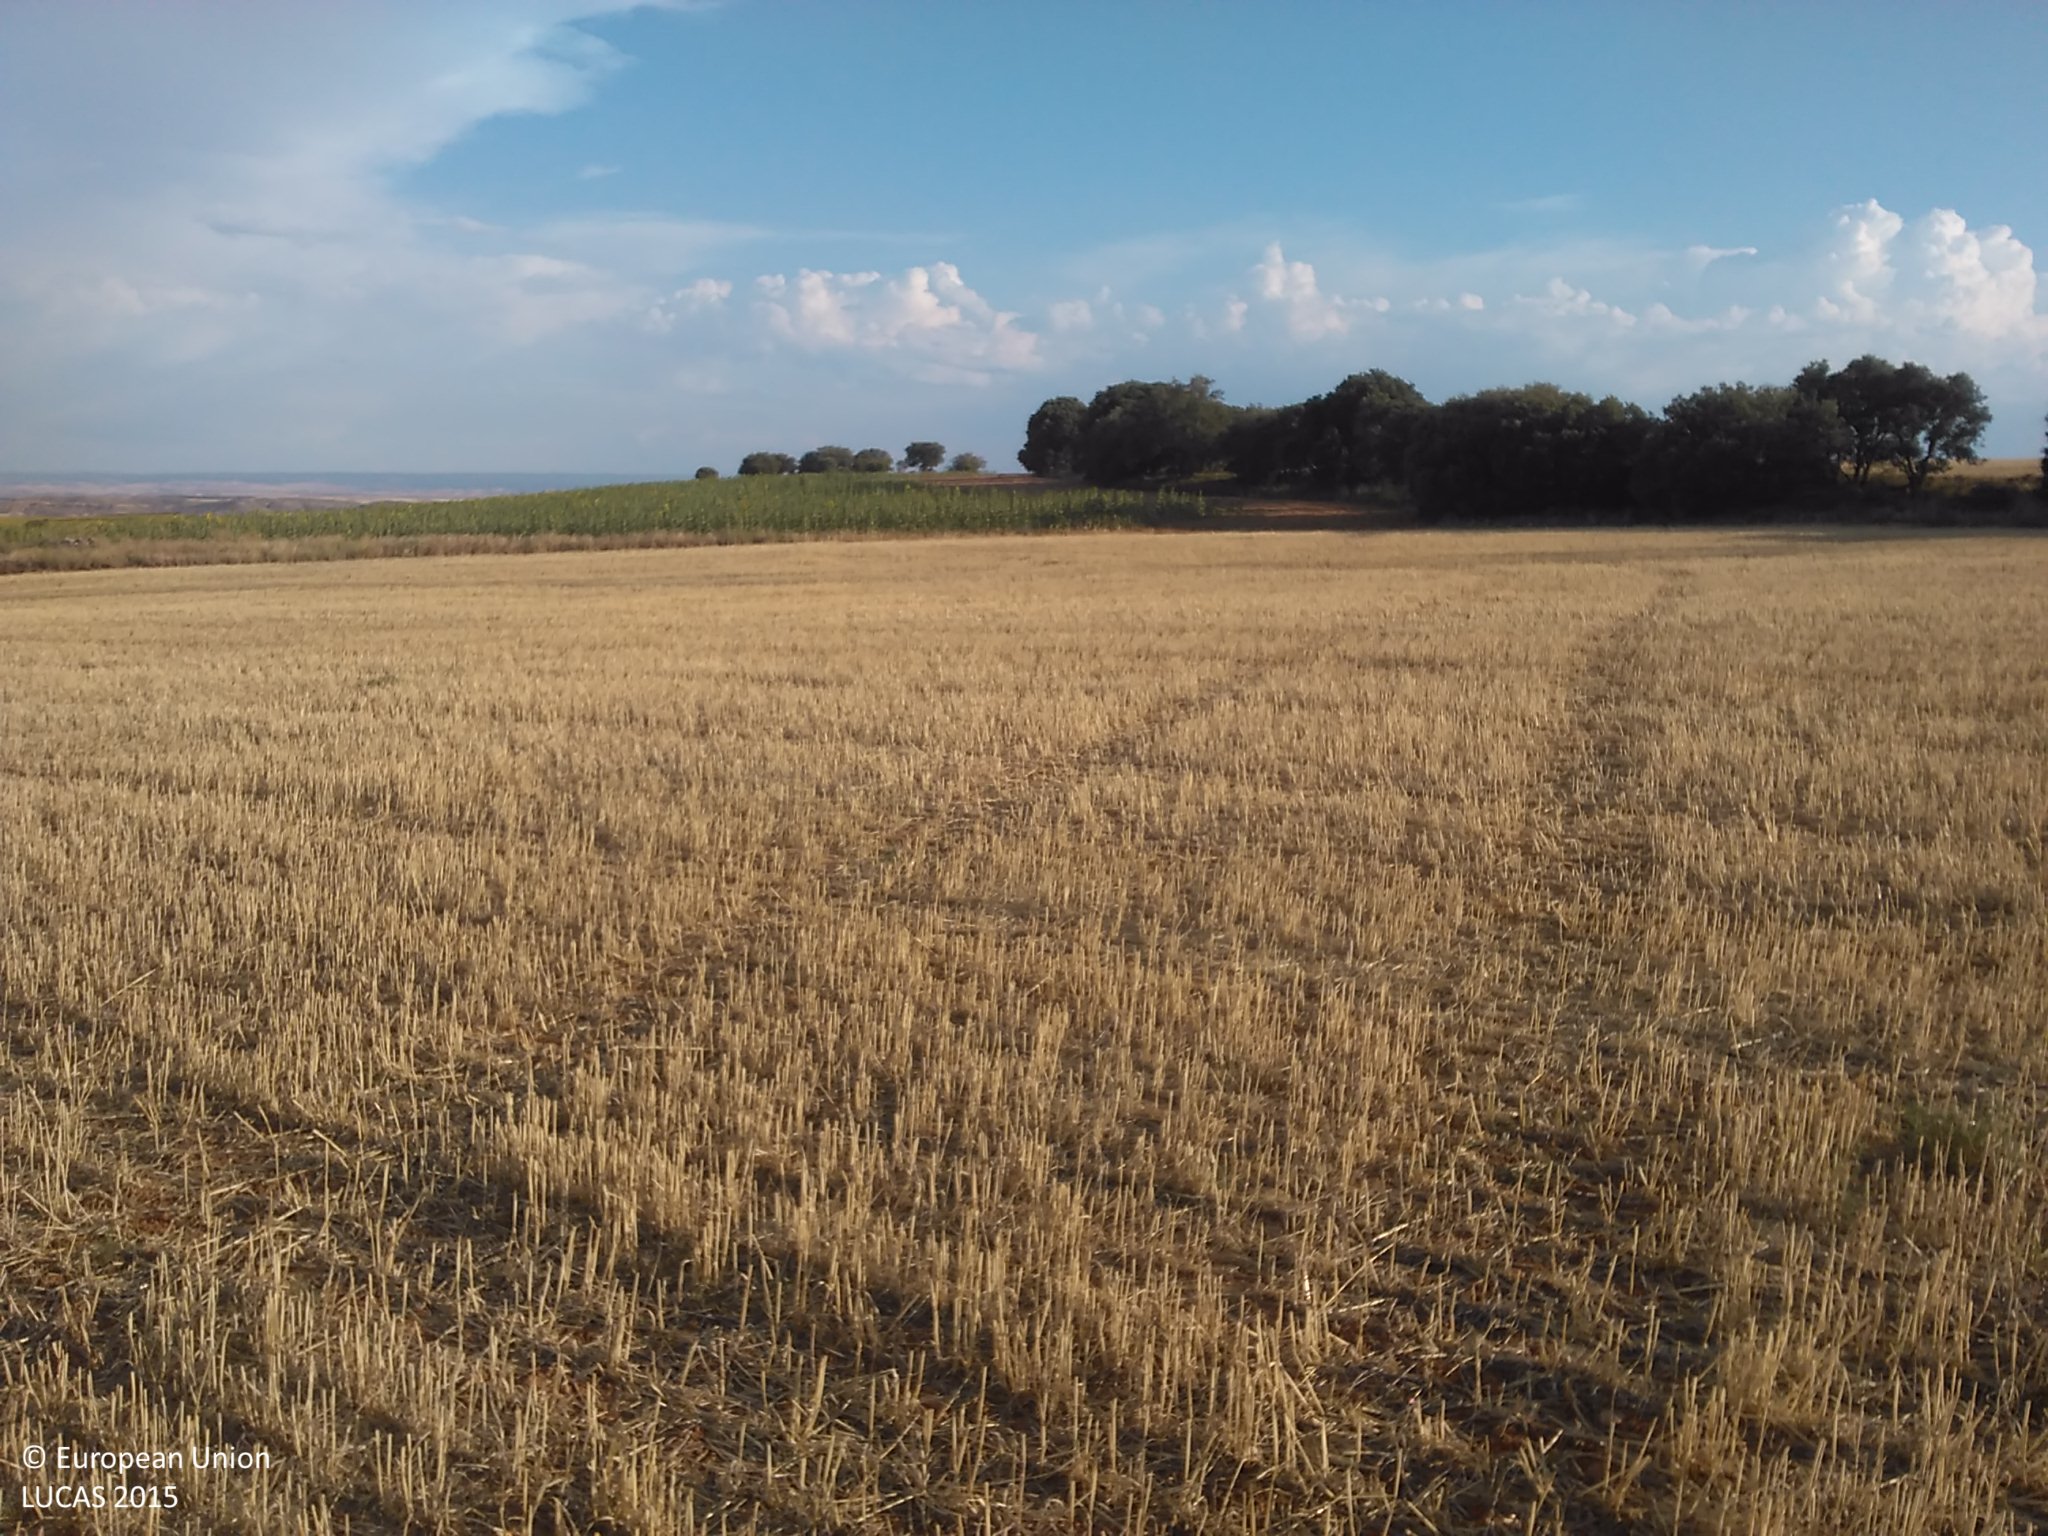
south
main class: Cropland
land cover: Barley
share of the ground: < 10 %
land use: Agriculture (excluding fallow land and kitchen gardens)
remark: Harvested field
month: July
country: ES
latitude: 41.4179
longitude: -2.2233
